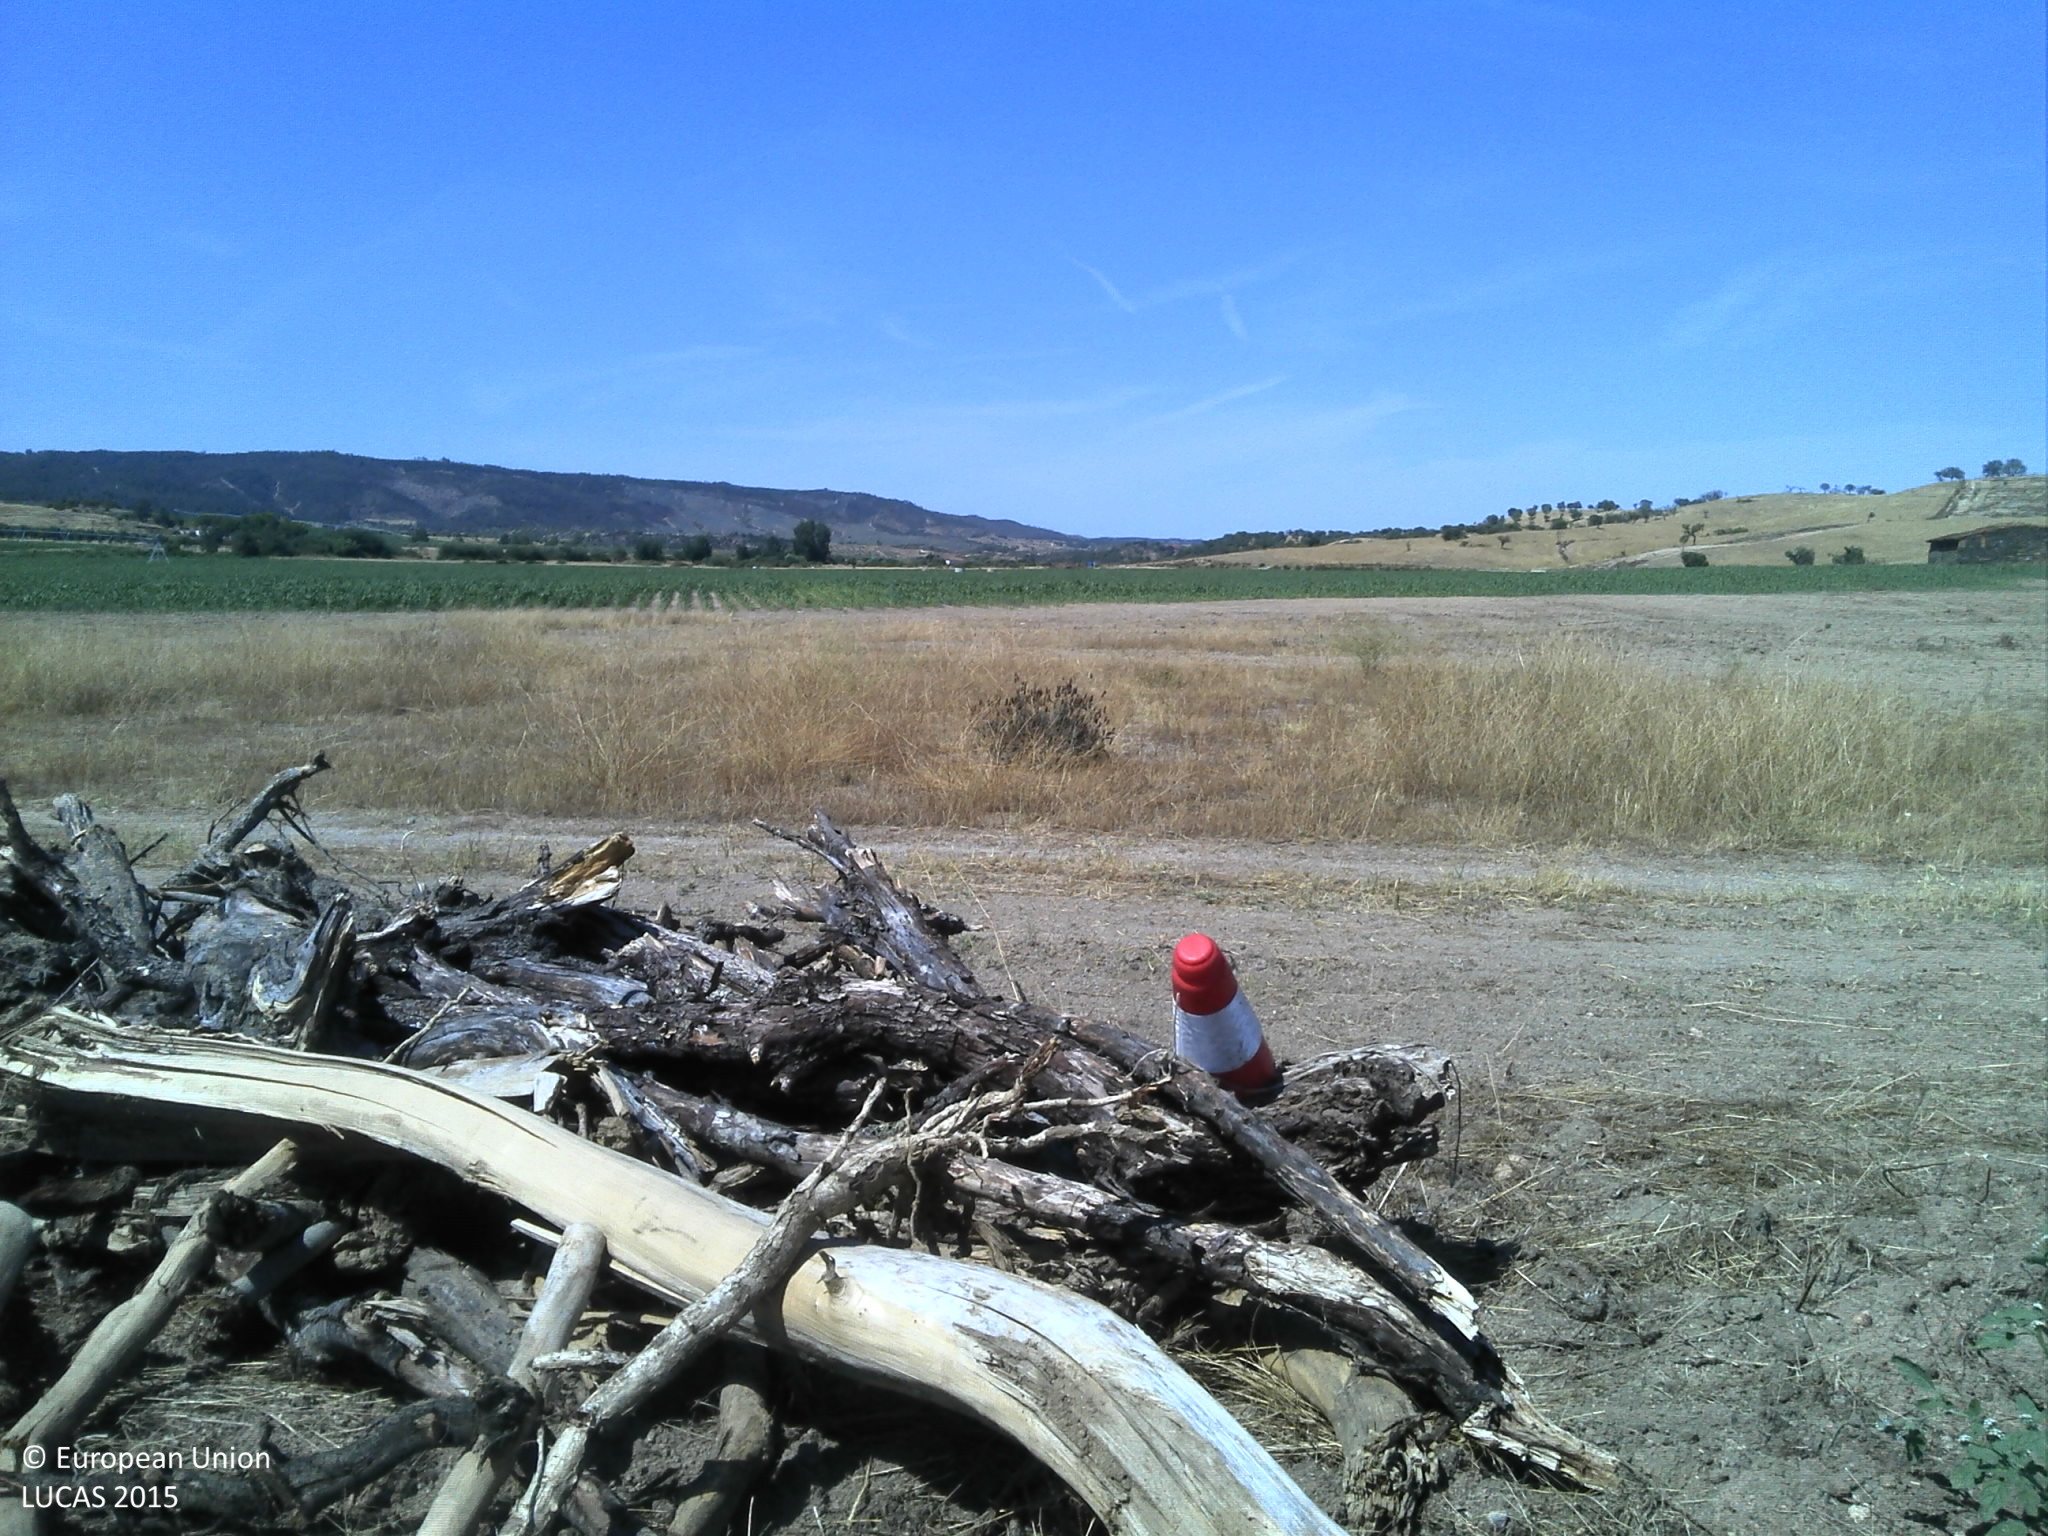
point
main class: Grassland
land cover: Spontaneously vegetated surfaces
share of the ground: 25 - 50 %
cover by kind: unconsolidated bare surface 50 %, herbaceous plants 45 %
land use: Agriculture (excluding fallow land and kitchen gardens)
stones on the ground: 10 - 25 %
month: July
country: PT
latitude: 39.6779
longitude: -7.5987
